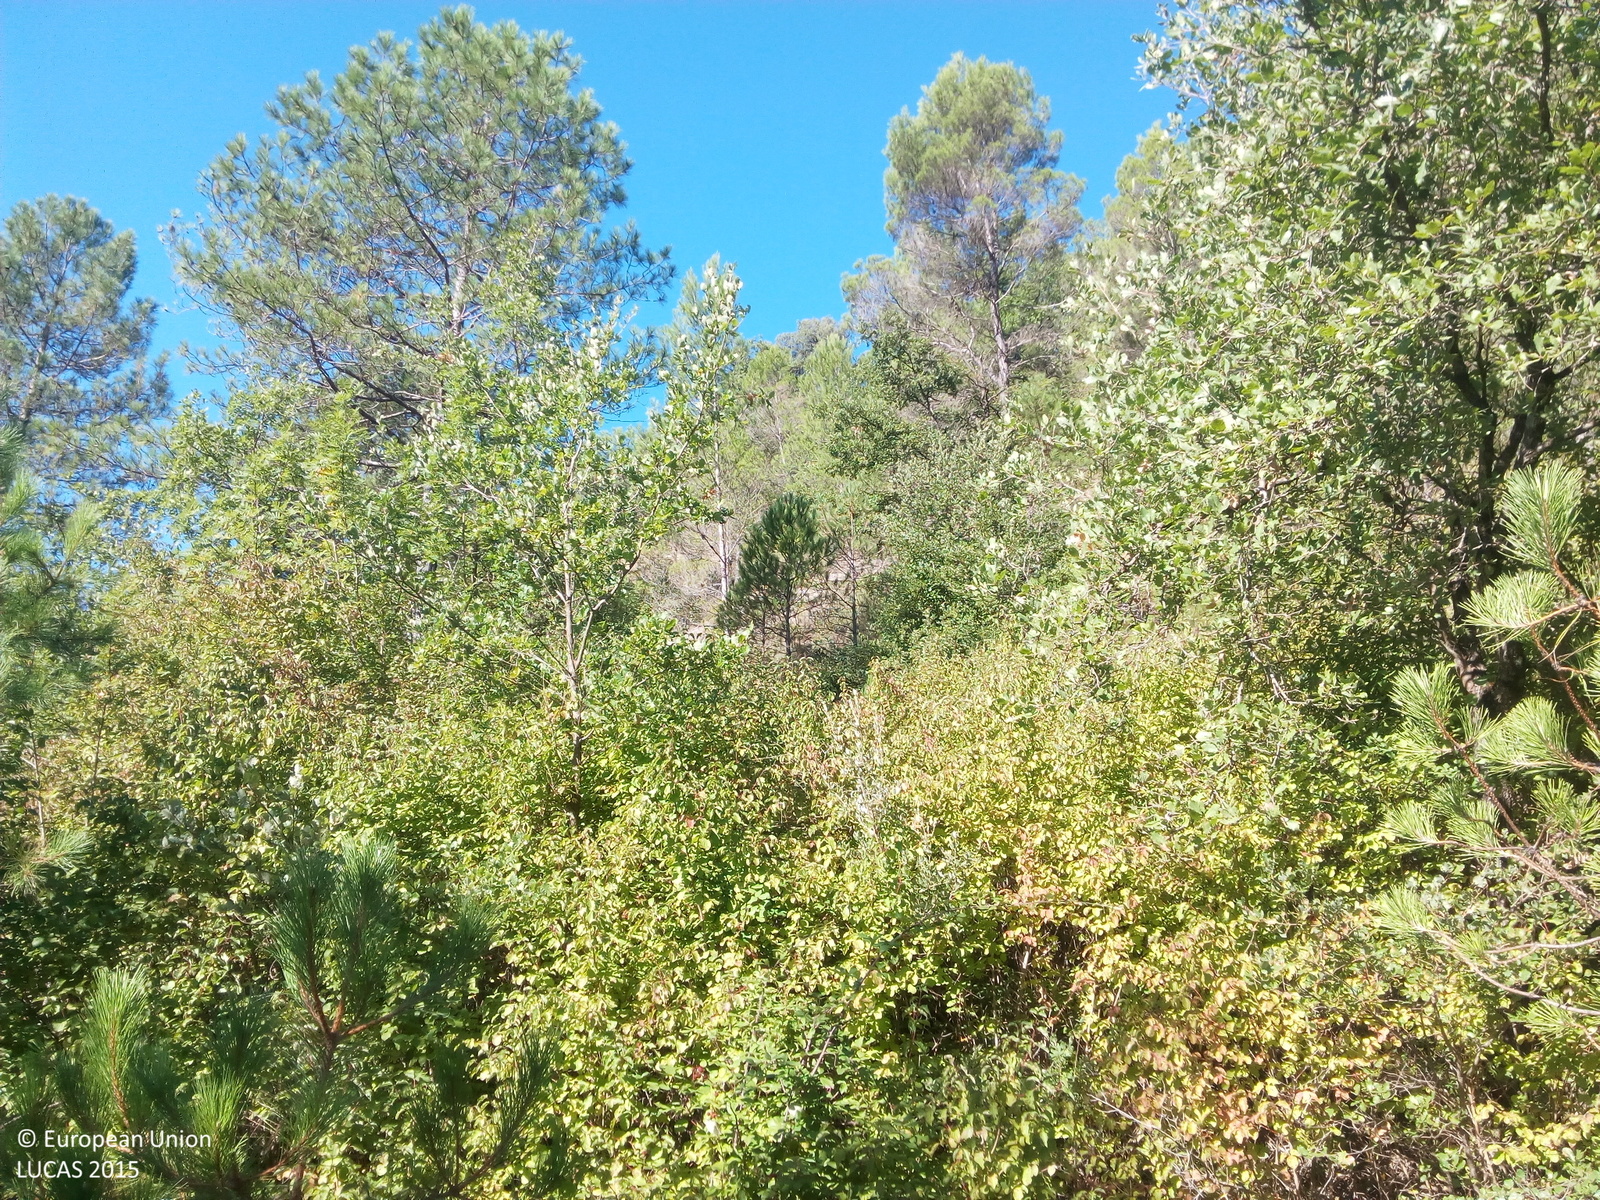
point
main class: Woodland
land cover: Pine dominated mixed woodland
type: alpine coniferous forest
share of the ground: > 75 %
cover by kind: coniferous forest trees 40 %, broadleaved forest trees 30 %, shrubs 20 %, consolidated bare surface 10 %
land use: Semi-natural and natural areas not in use
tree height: > 5 m
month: August
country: ES
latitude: 42.4161
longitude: 0.2211
